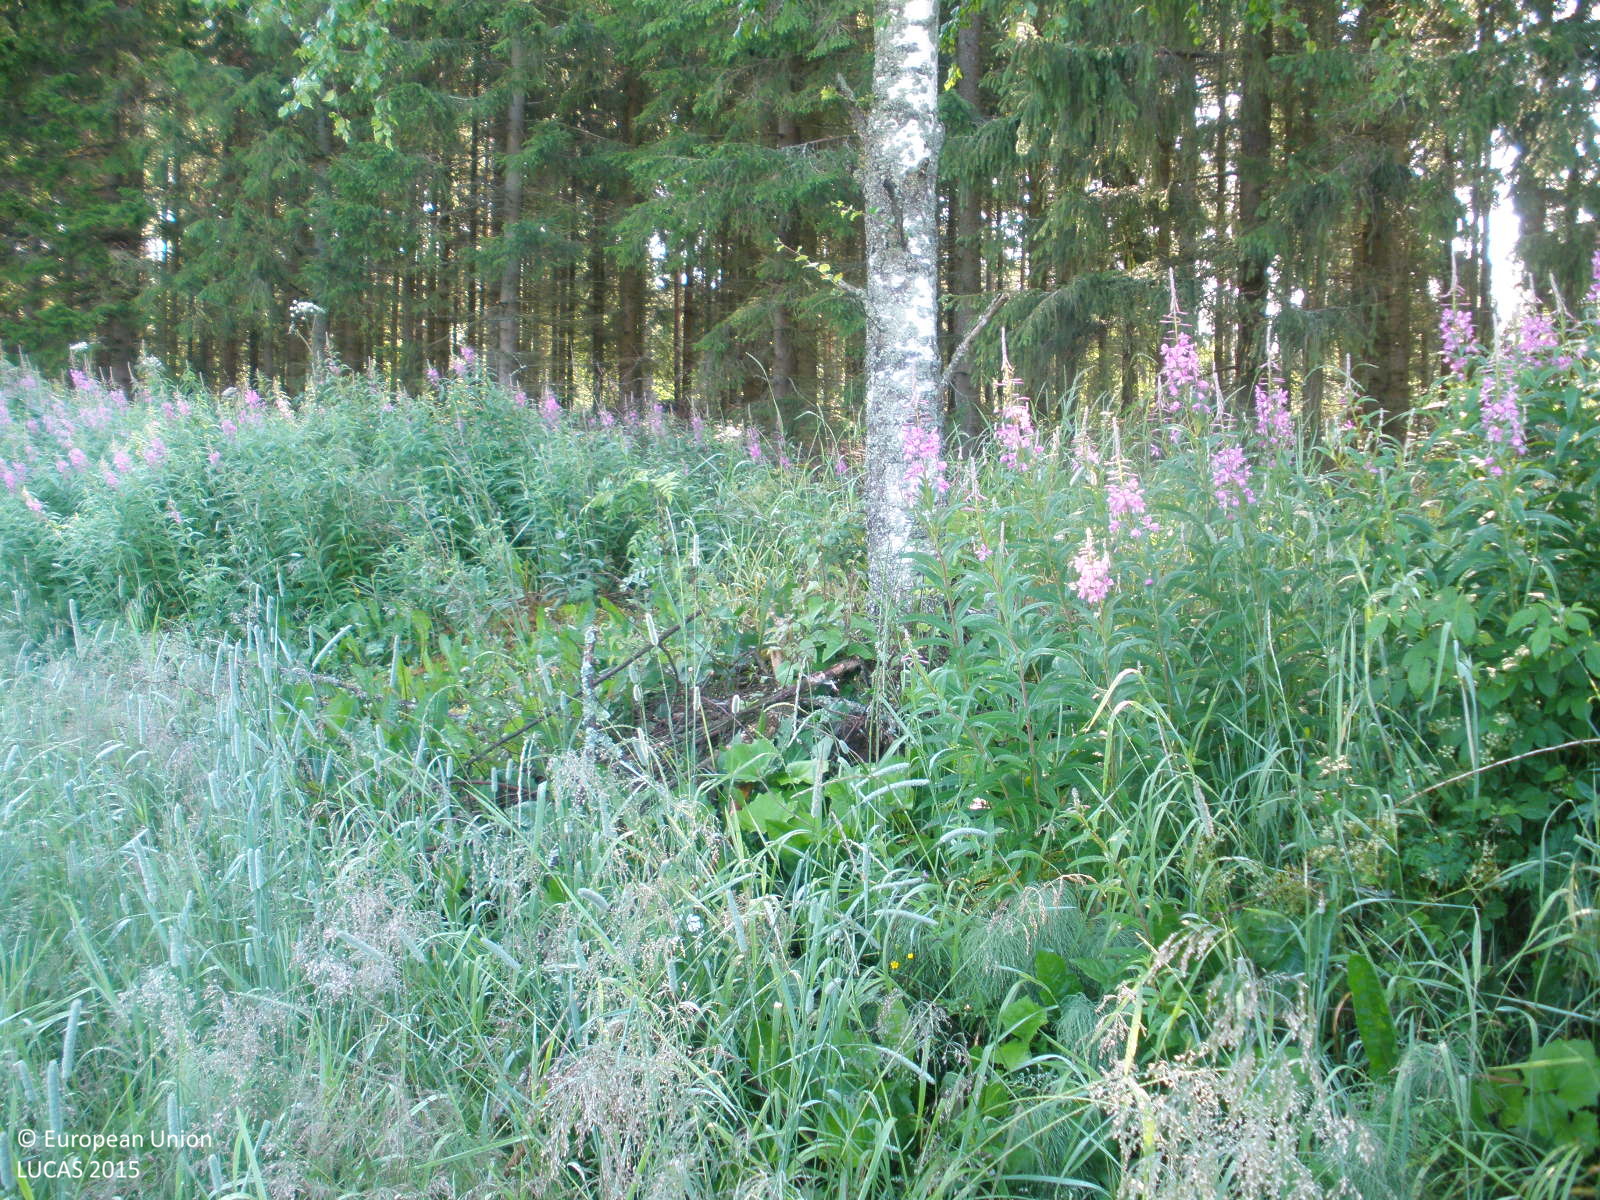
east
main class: Cropland
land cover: Common wheat
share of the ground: > 75 %
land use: Agriculture (excluding fallow land and kitchen gardens)
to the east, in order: Common wheat; Grass margins; Ditches and canals; Grass margins; Spruce dominated mixed woodland; Pine dominated coniferous woodland; Artificial constructions in urban areas; Spruce dominated coniferous woodland
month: July
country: FI
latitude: 61.5701
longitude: 24.5407
